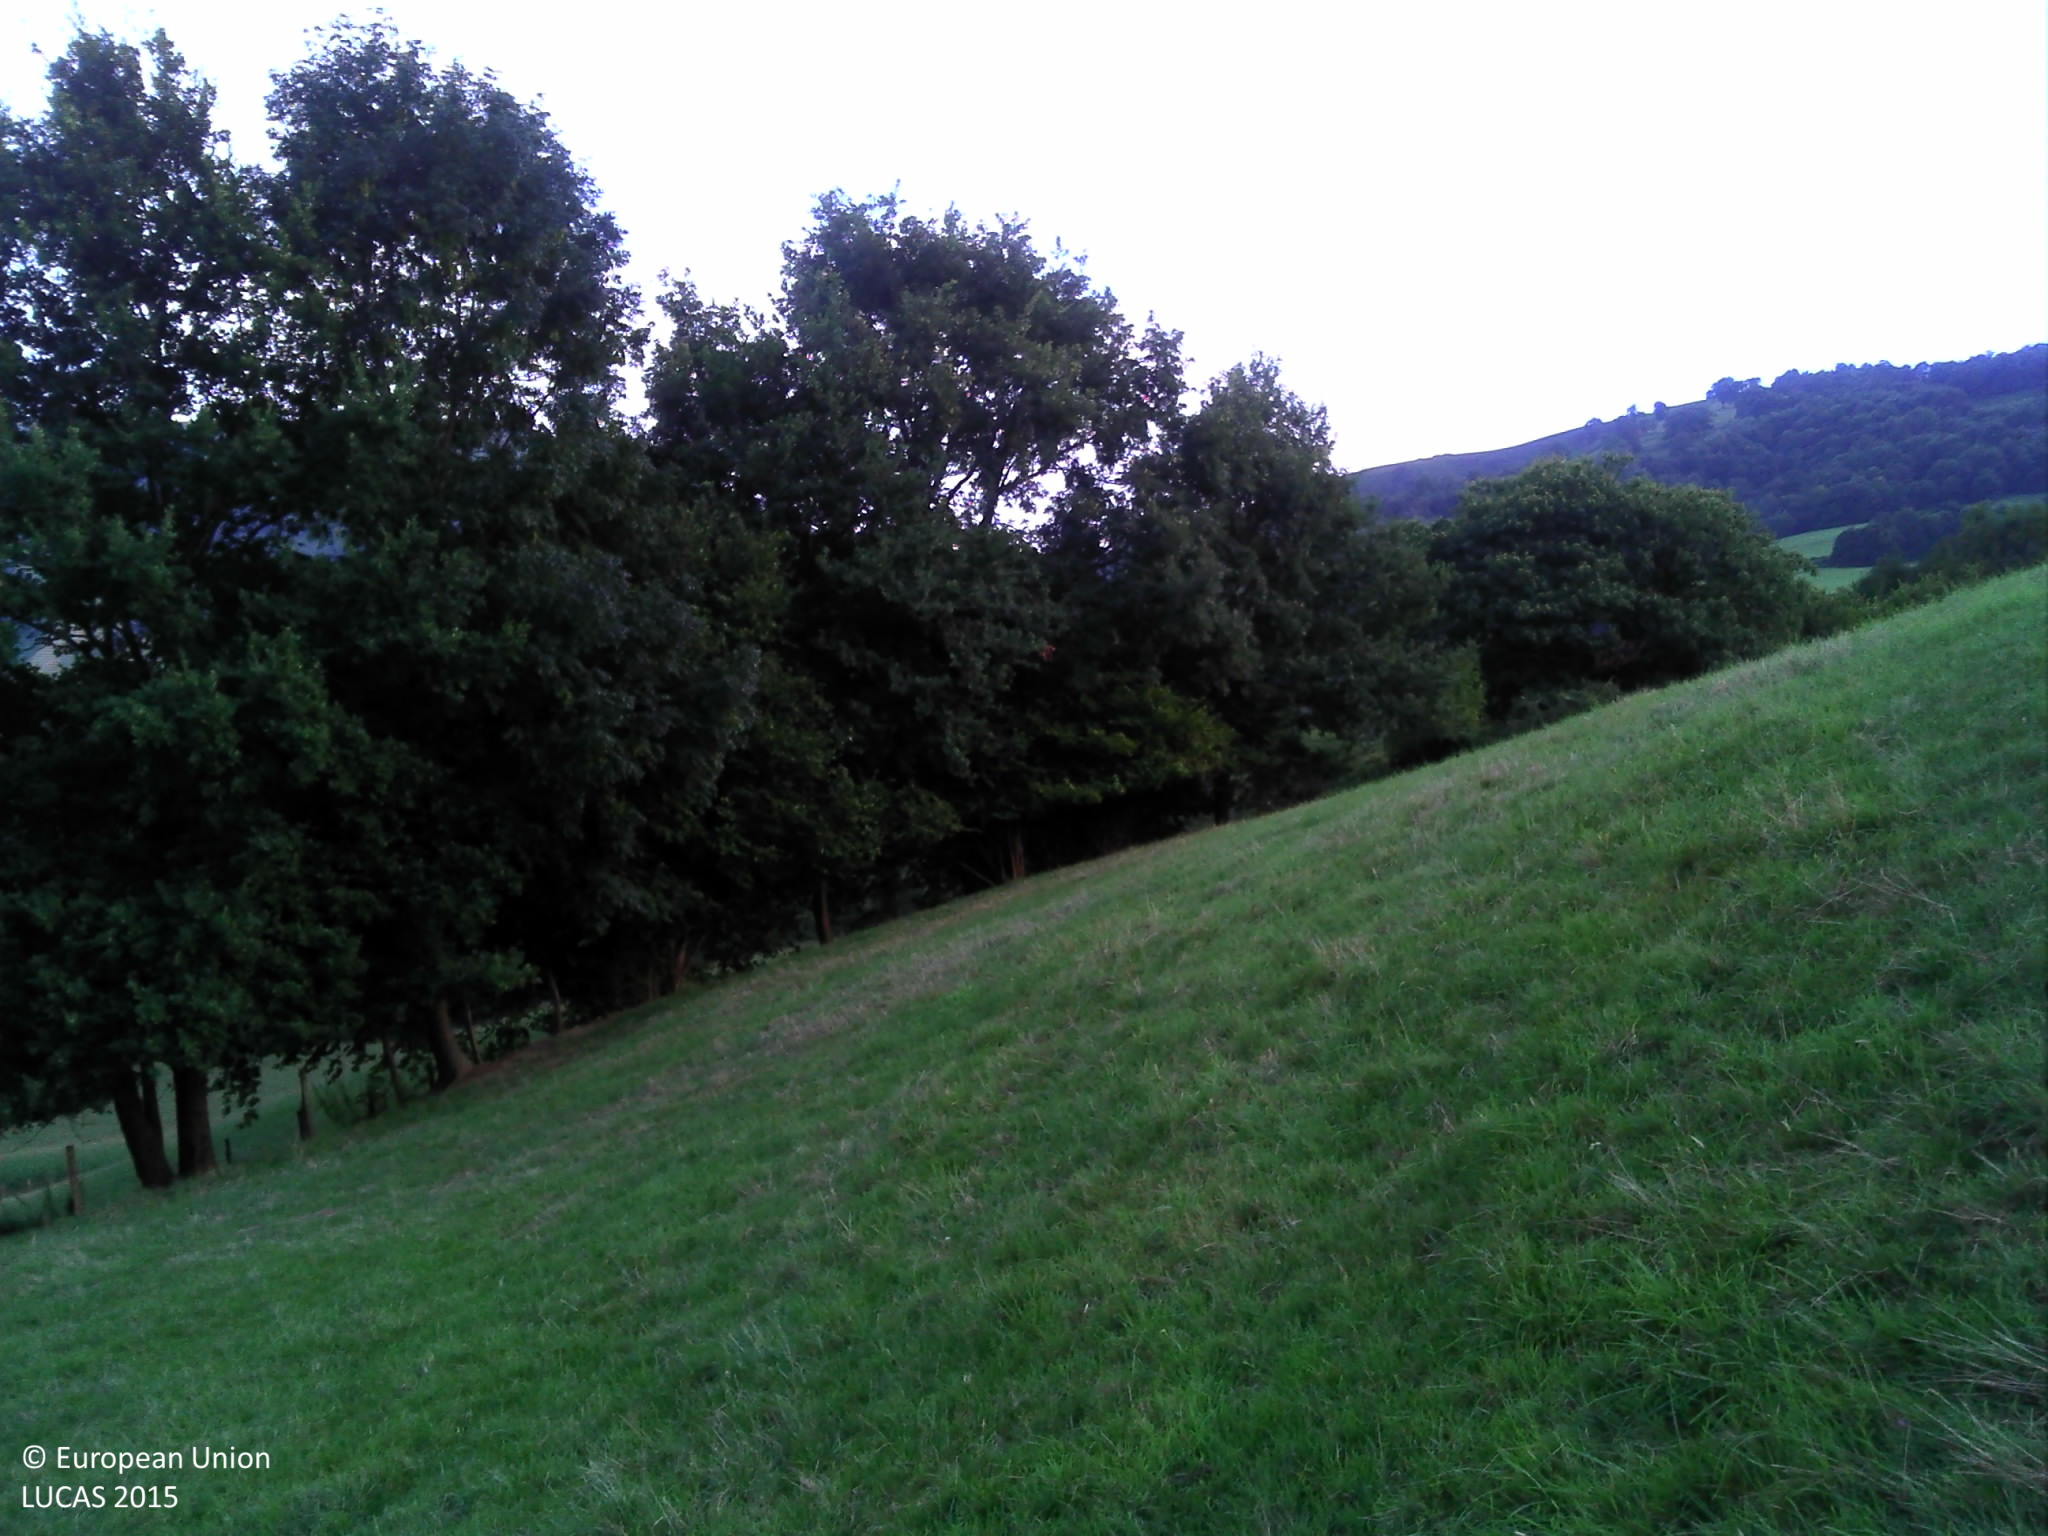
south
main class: Grassland
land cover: Grassland without tree/shrub cover
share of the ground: > 75 %
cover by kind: herbaceous plants 100 %
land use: Agriculture (excluding fallow land and kitchen gardens)
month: August
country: FR
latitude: 43.2703
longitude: -1.1888
